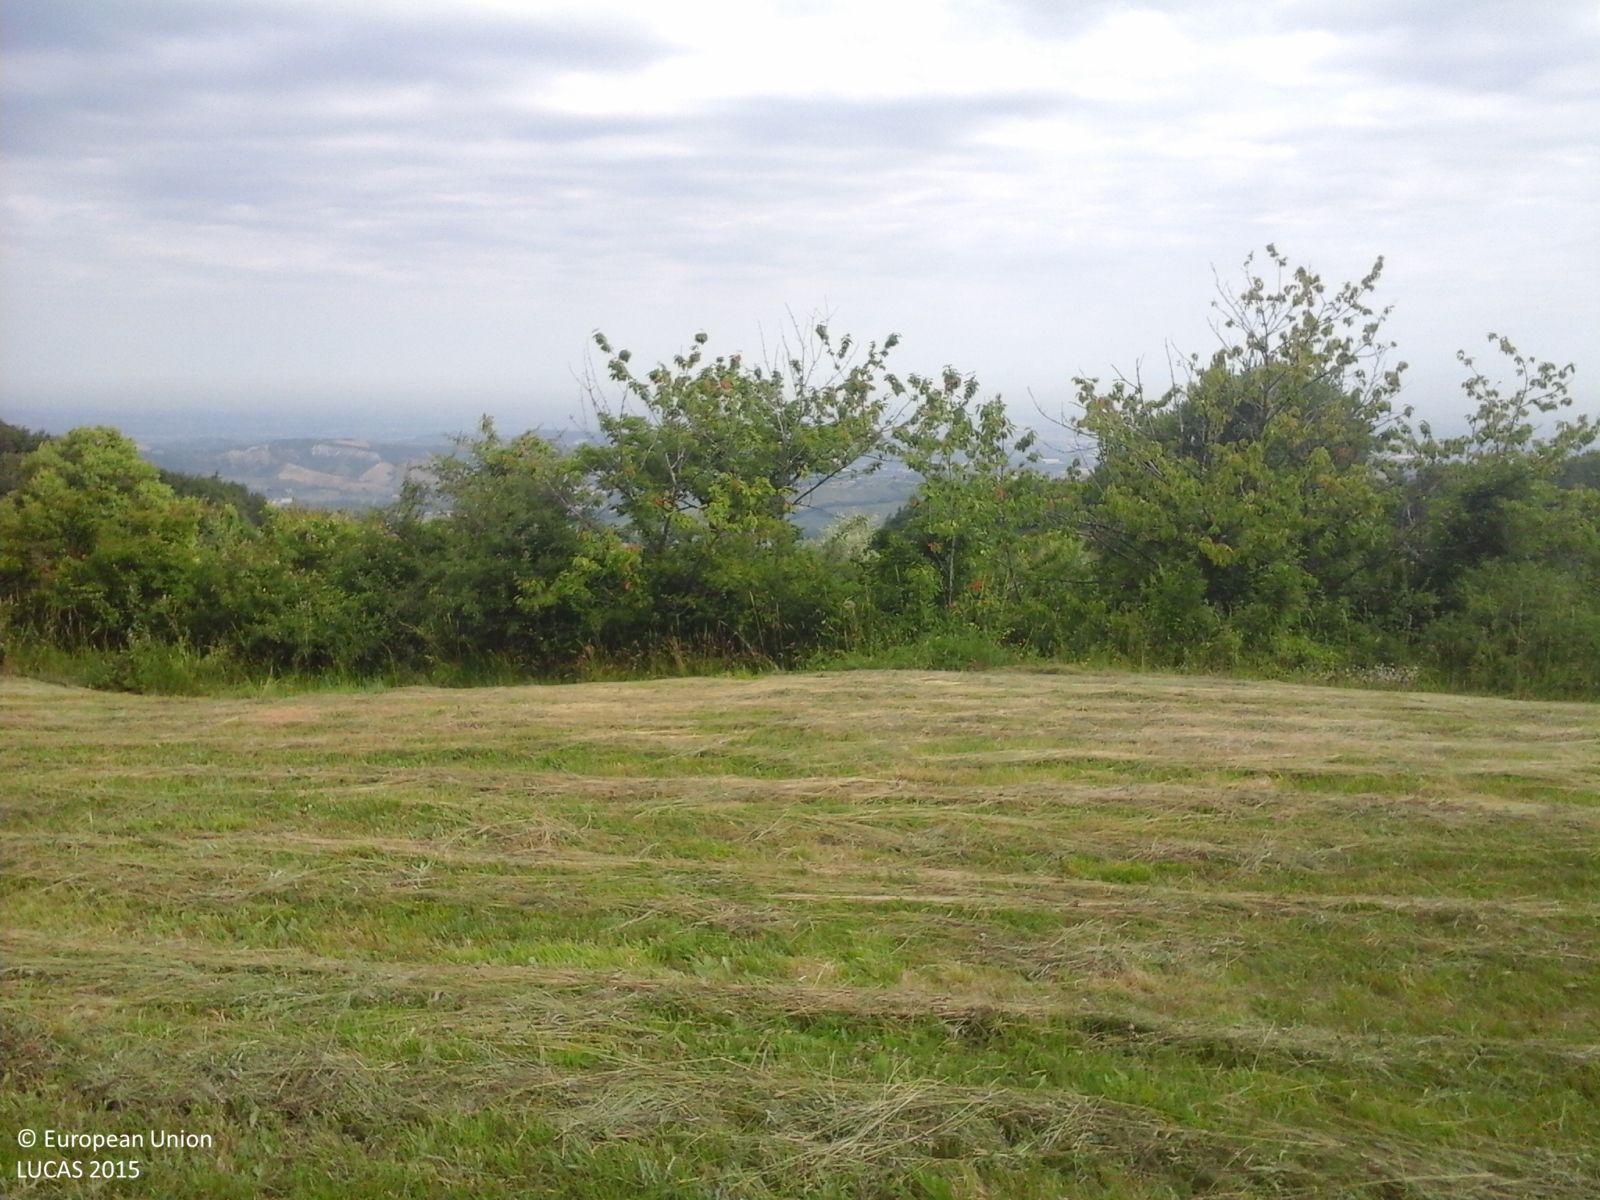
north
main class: Woodland
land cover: Broadleaved woodland
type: thermophilous deciduous forest
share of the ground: > 75 %
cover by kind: broadleaved forest trees 95 %, coniferous forest trees 5 %
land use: Forestry
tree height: > 5 m
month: June
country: IT
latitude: 44.6208
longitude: 10.2138
